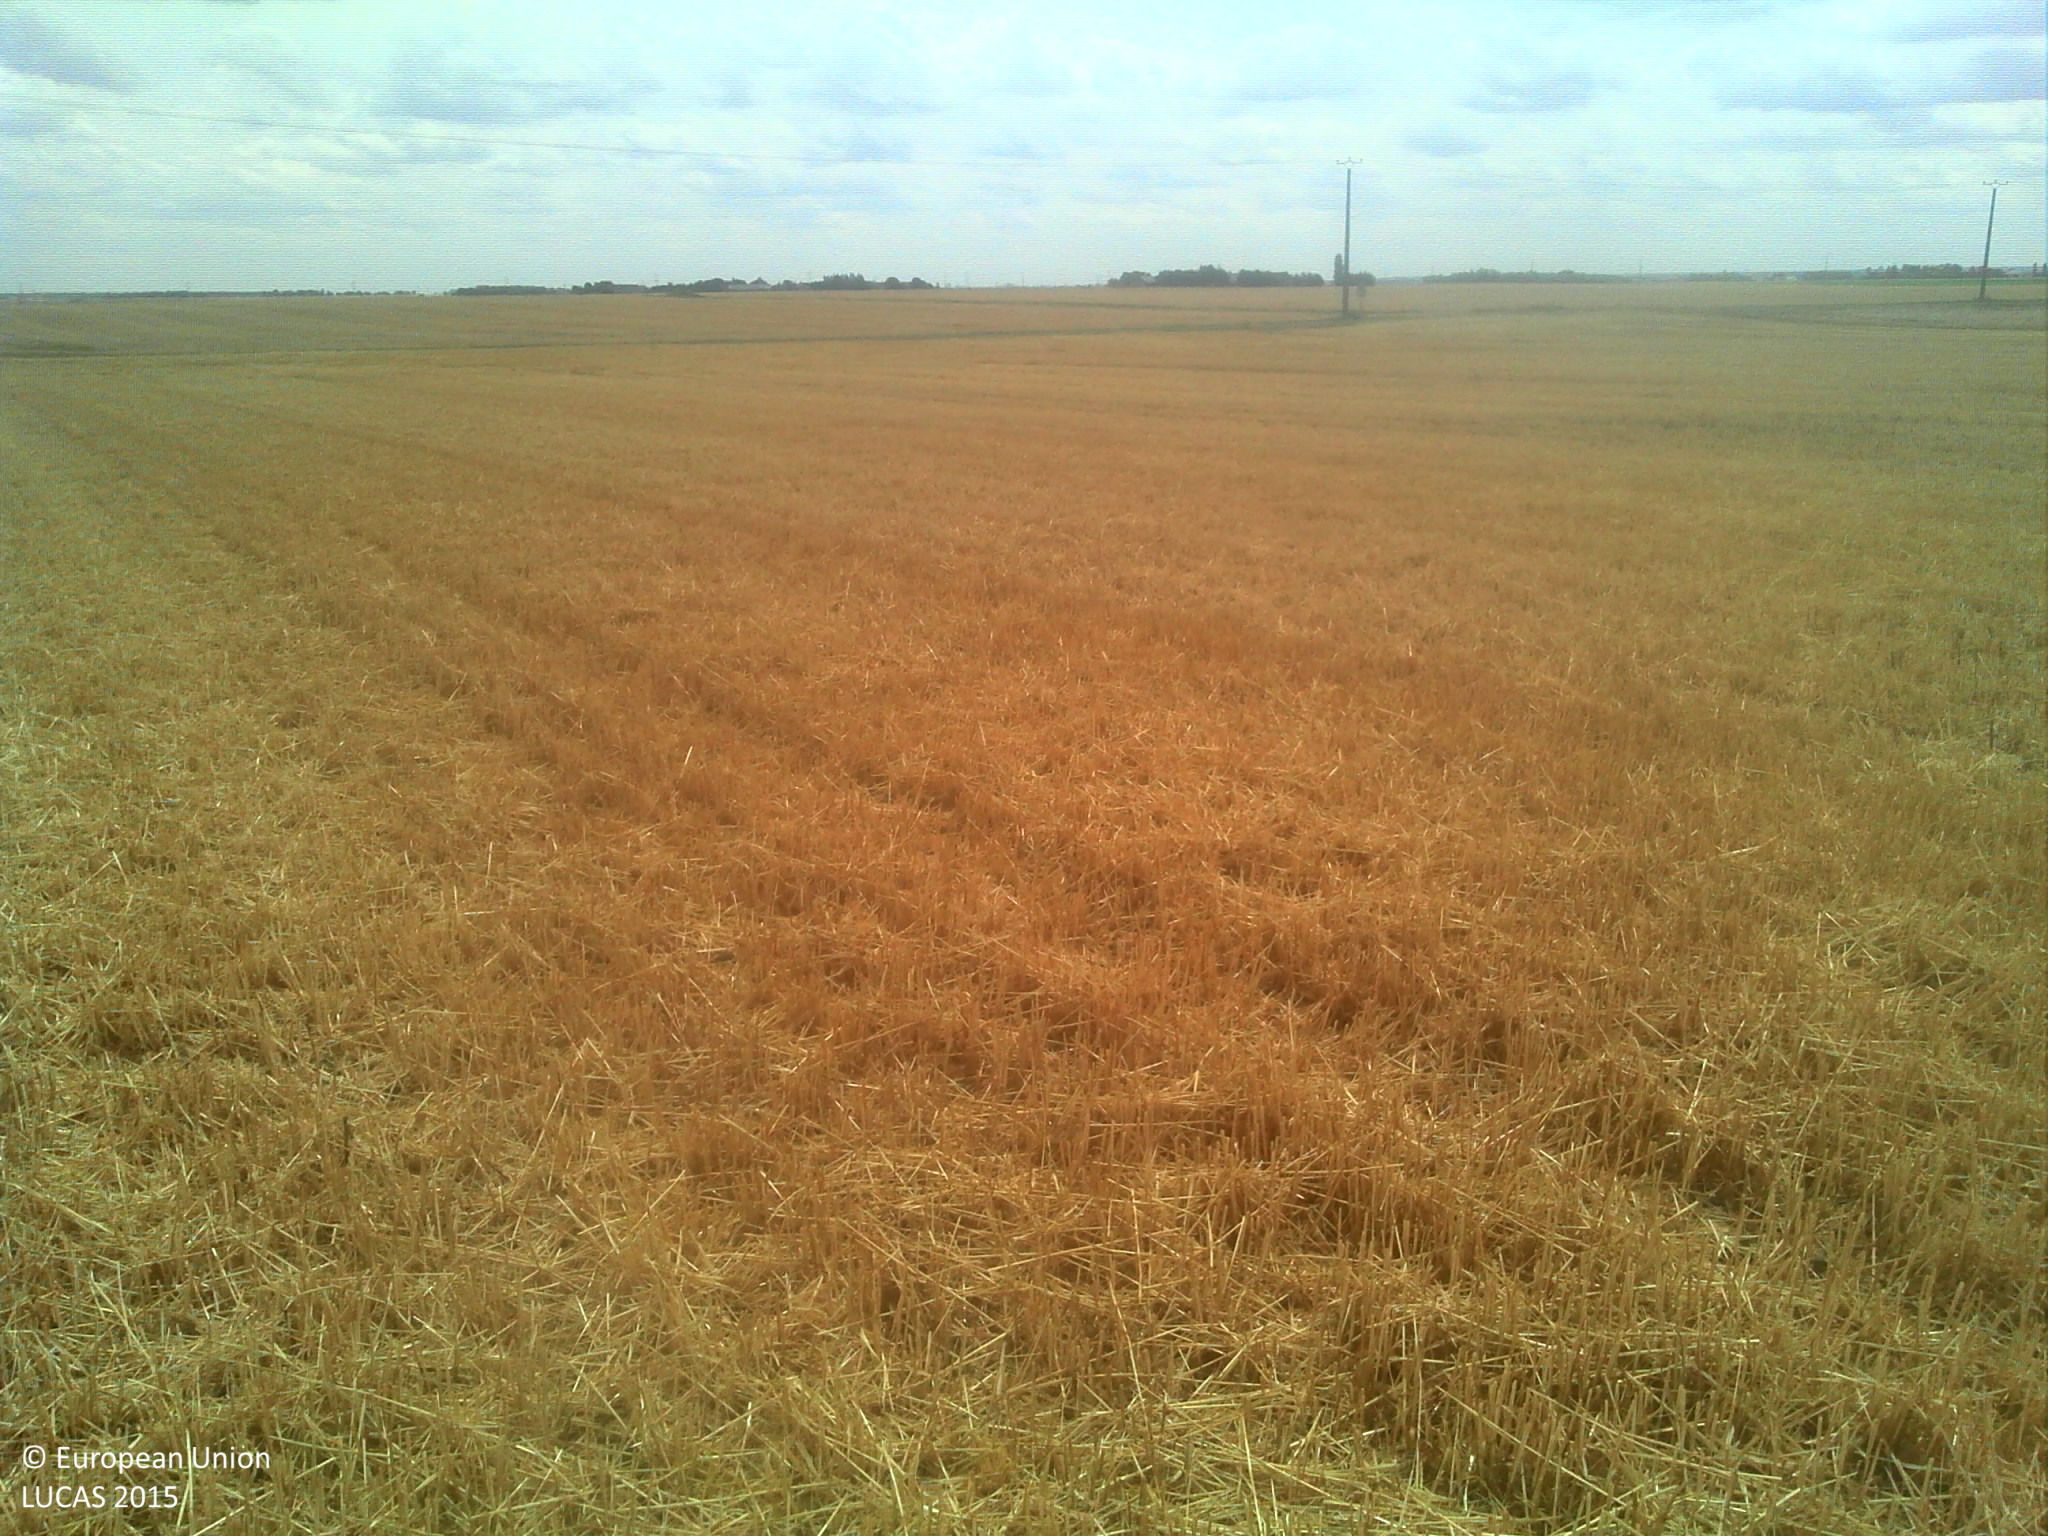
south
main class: Cropland
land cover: Durum wheat
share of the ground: > 75 %
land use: Agriculture (excluding fallow land and kitchen gardens)
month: July
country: FR
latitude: 47.7209
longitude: 1.3592
